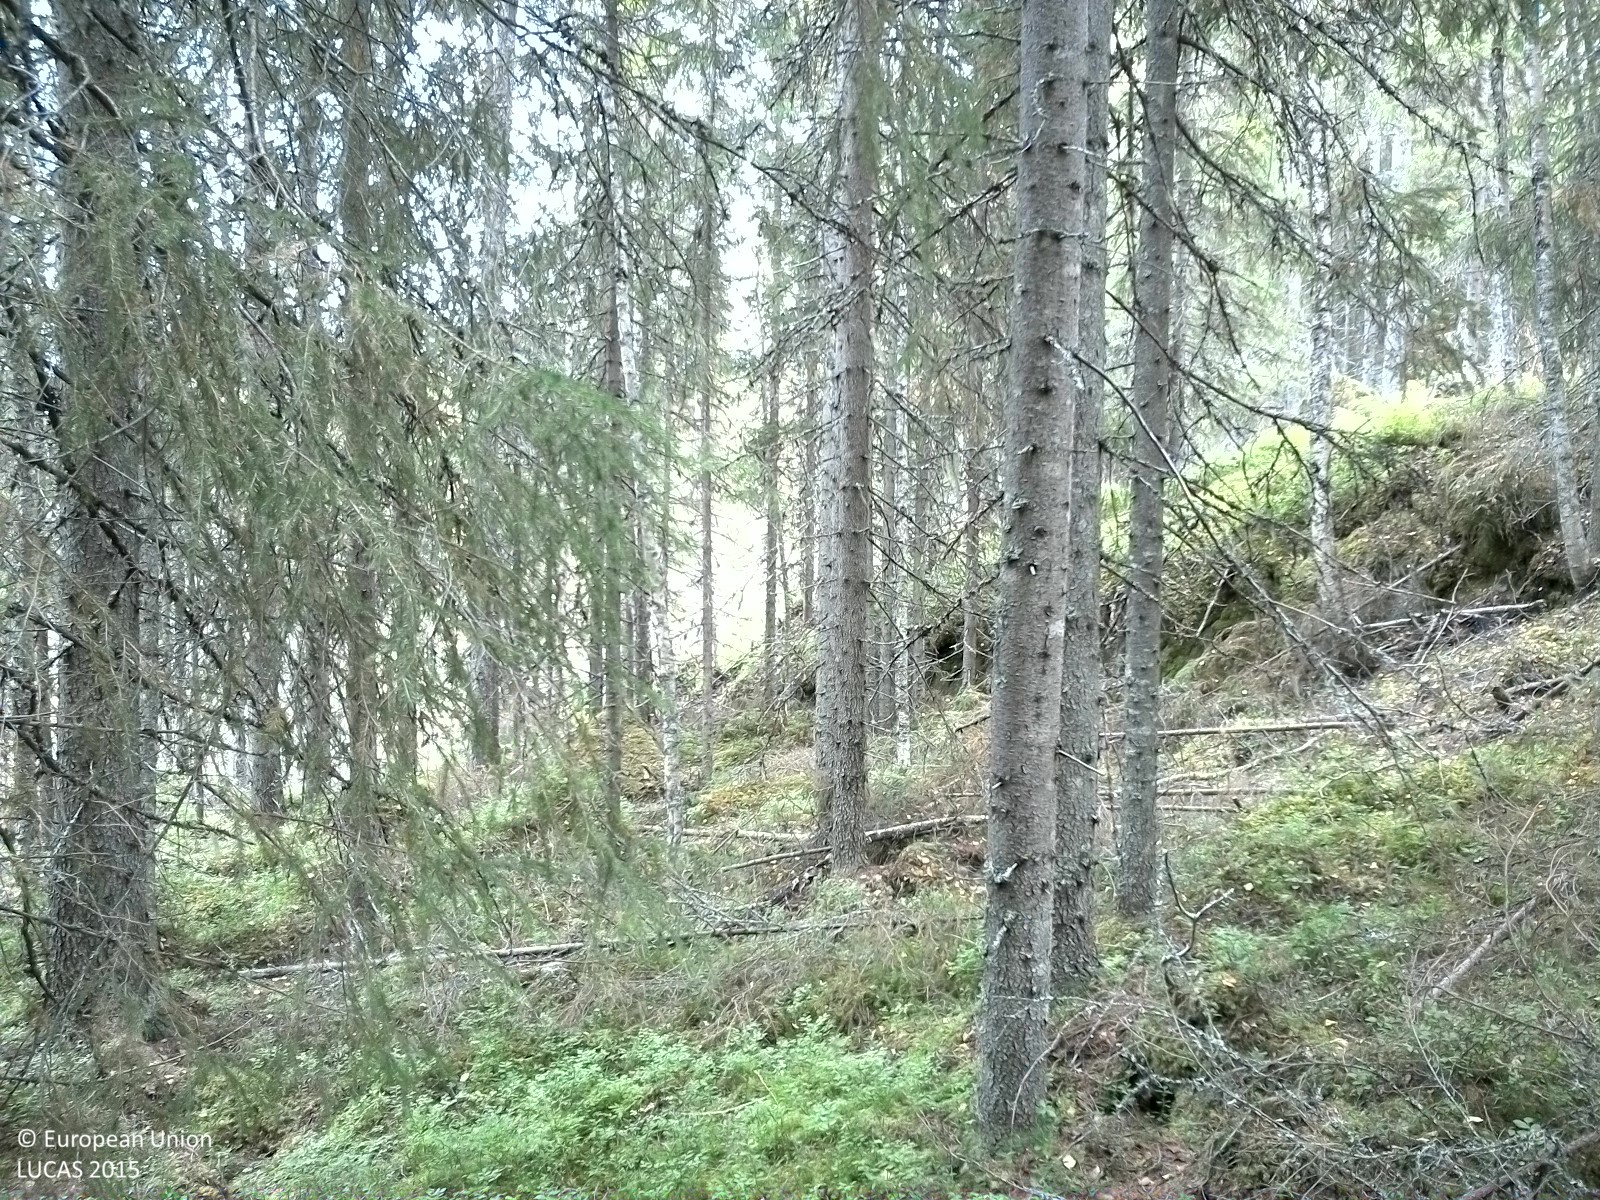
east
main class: Woodland
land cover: Spruce dominated coniferous woodland
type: boreal forest
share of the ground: 50 - 75 %
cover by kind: coniferous forest trees 60 %, shrubs 20 %, lichens and mosses 20 %
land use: Forestry
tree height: > 5 m
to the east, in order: Spruce dominated coniferous woodland; Spruce dominated mixed woodland; Other mixed woodland; Spruce dominated mixed woodland; Pine dominated mixed woodland; Other mixed woodland
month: September
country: SE
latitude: 62.5268
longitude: 16.4881
